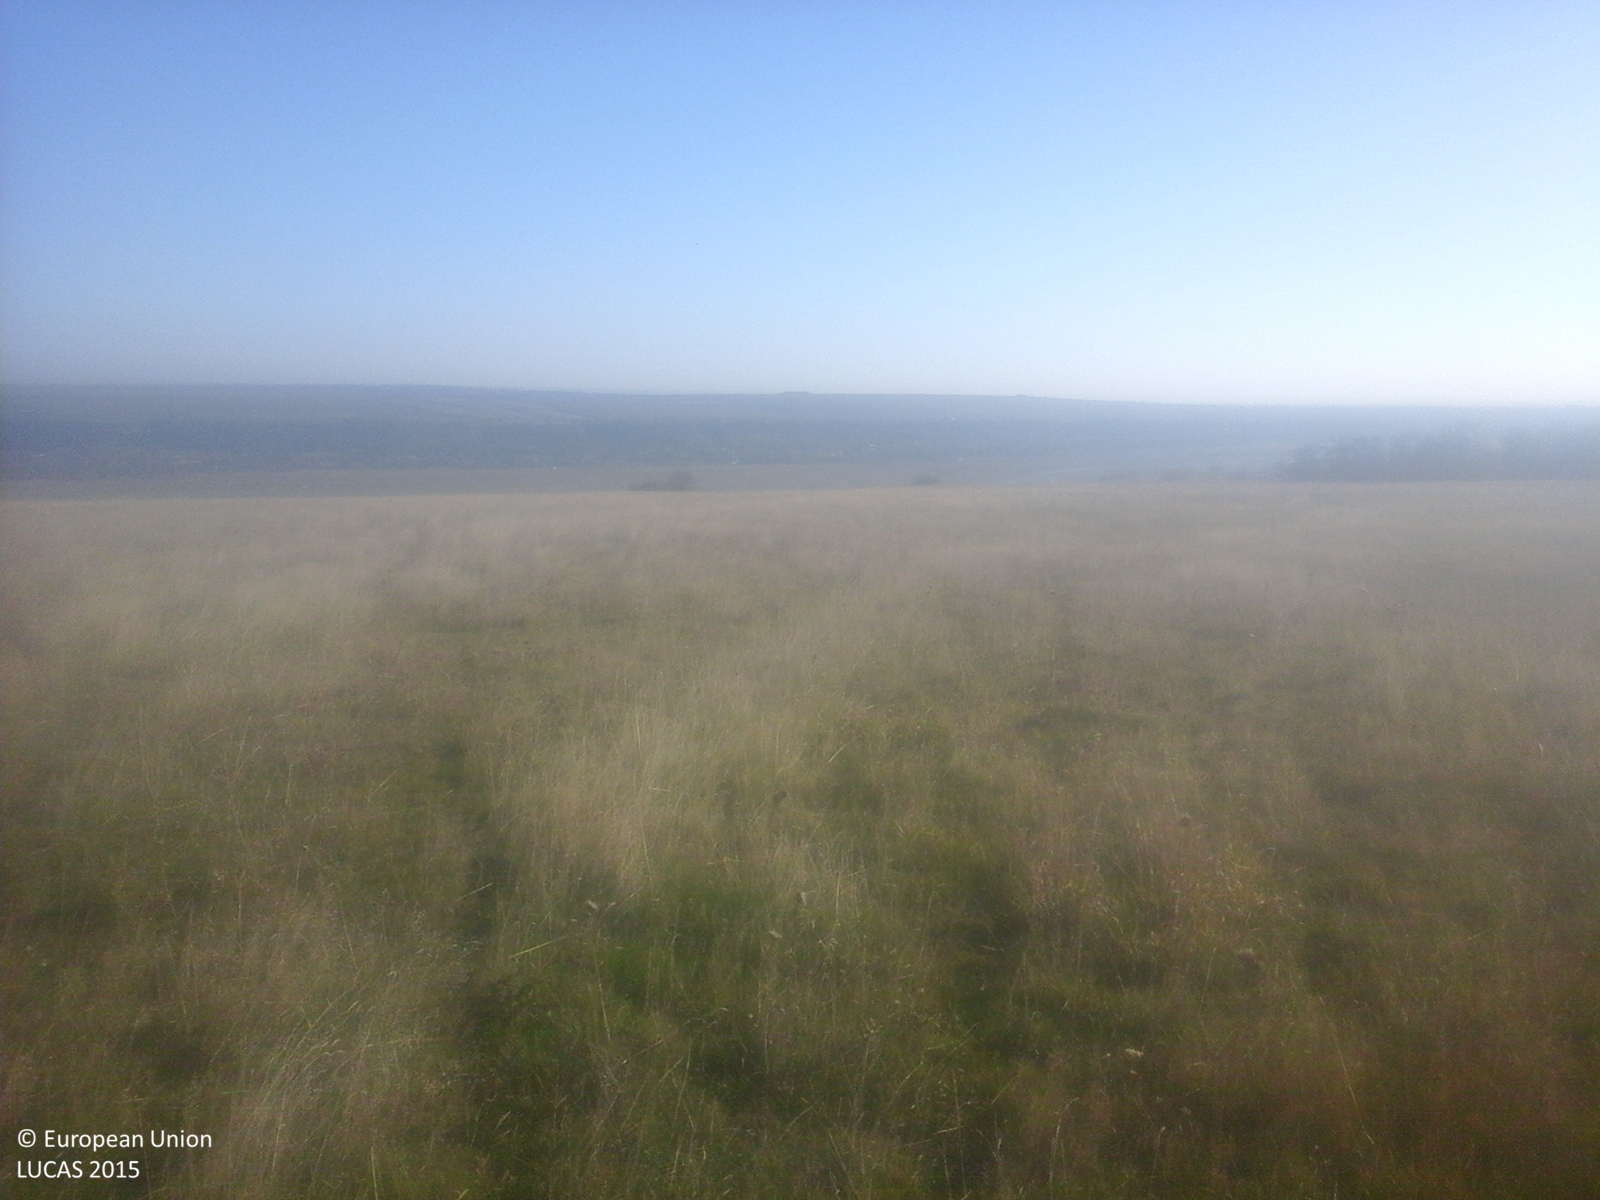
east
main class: Grassland
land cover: Grassland without tree/shrub cover
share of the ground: > 75 %
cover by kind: herbaceous plants 100 %
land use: Agriculture (excluding fallow land and kitchen gardens)
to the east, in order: Grassland without tree/shrub cover
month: October
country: RO
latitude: 45.8774
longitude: 27.0080
